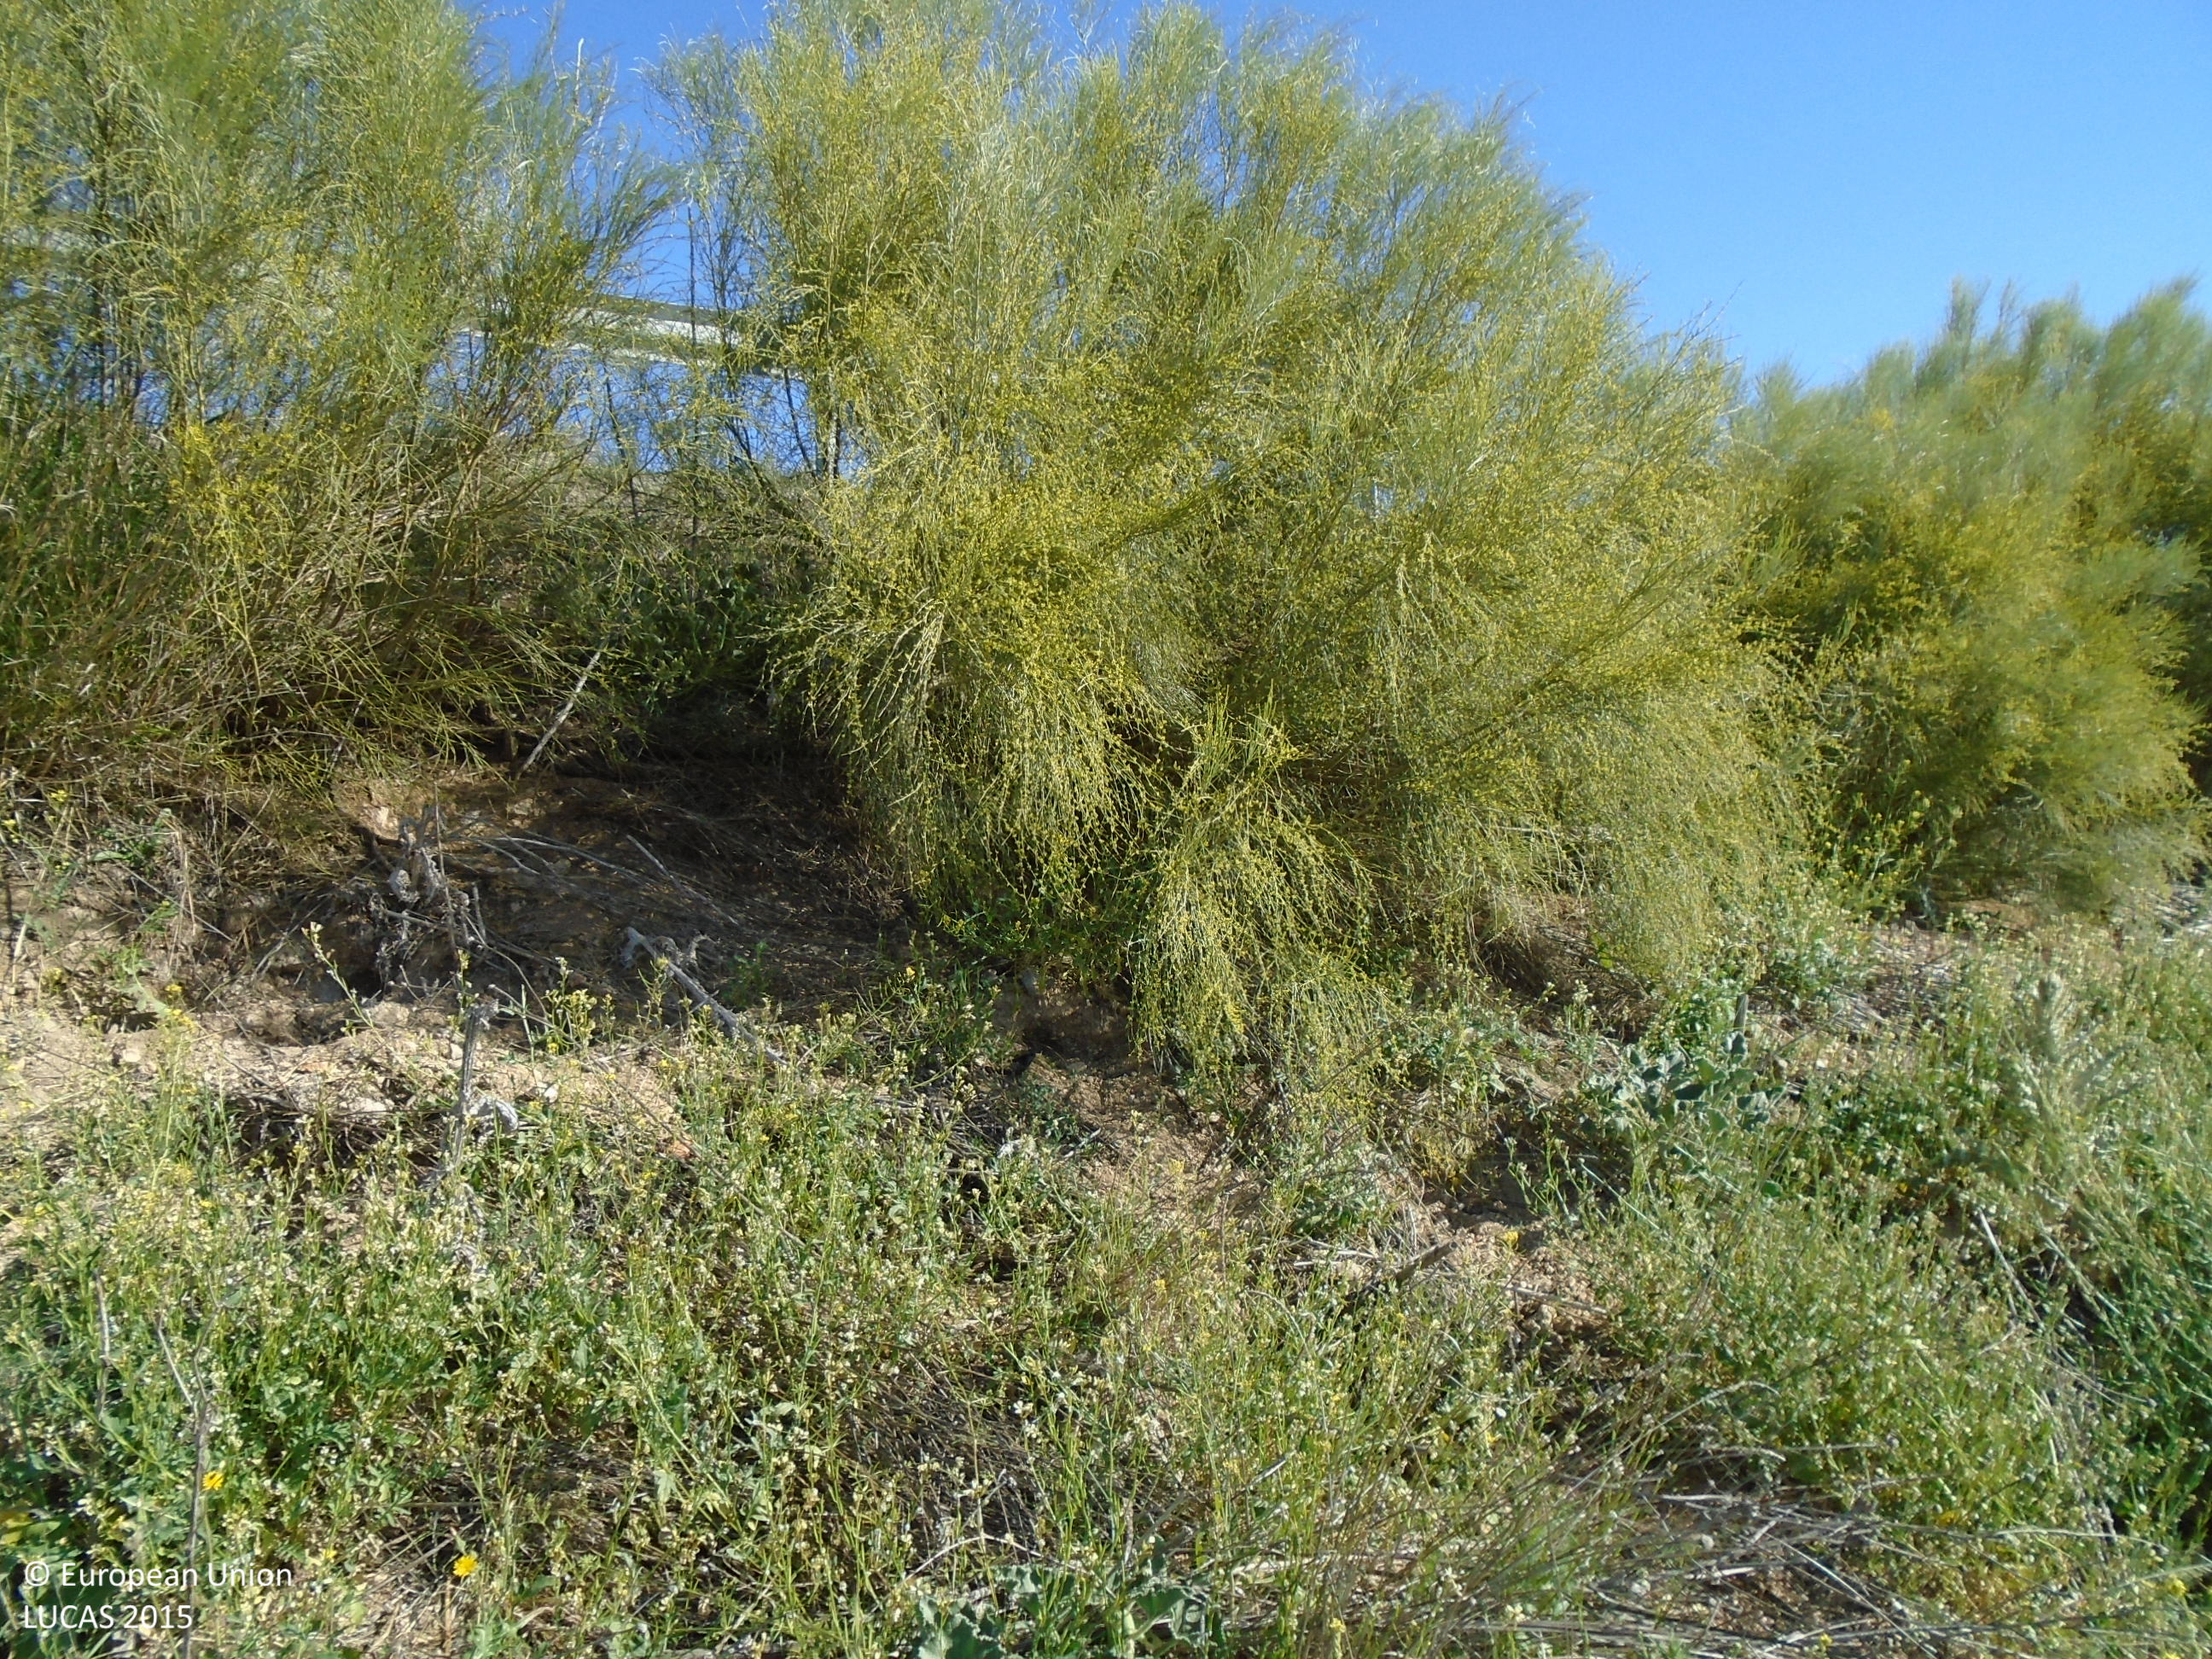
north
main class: Grassland
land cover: Spontaneously vegetated surfaces
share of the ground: > 75 %
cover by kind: herbaceous plants 95 %, consolidated bare surface 5 %
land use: Semi-natural and natural areas not in use
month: May
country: ES
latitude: 39.7177
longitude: -3.7354
